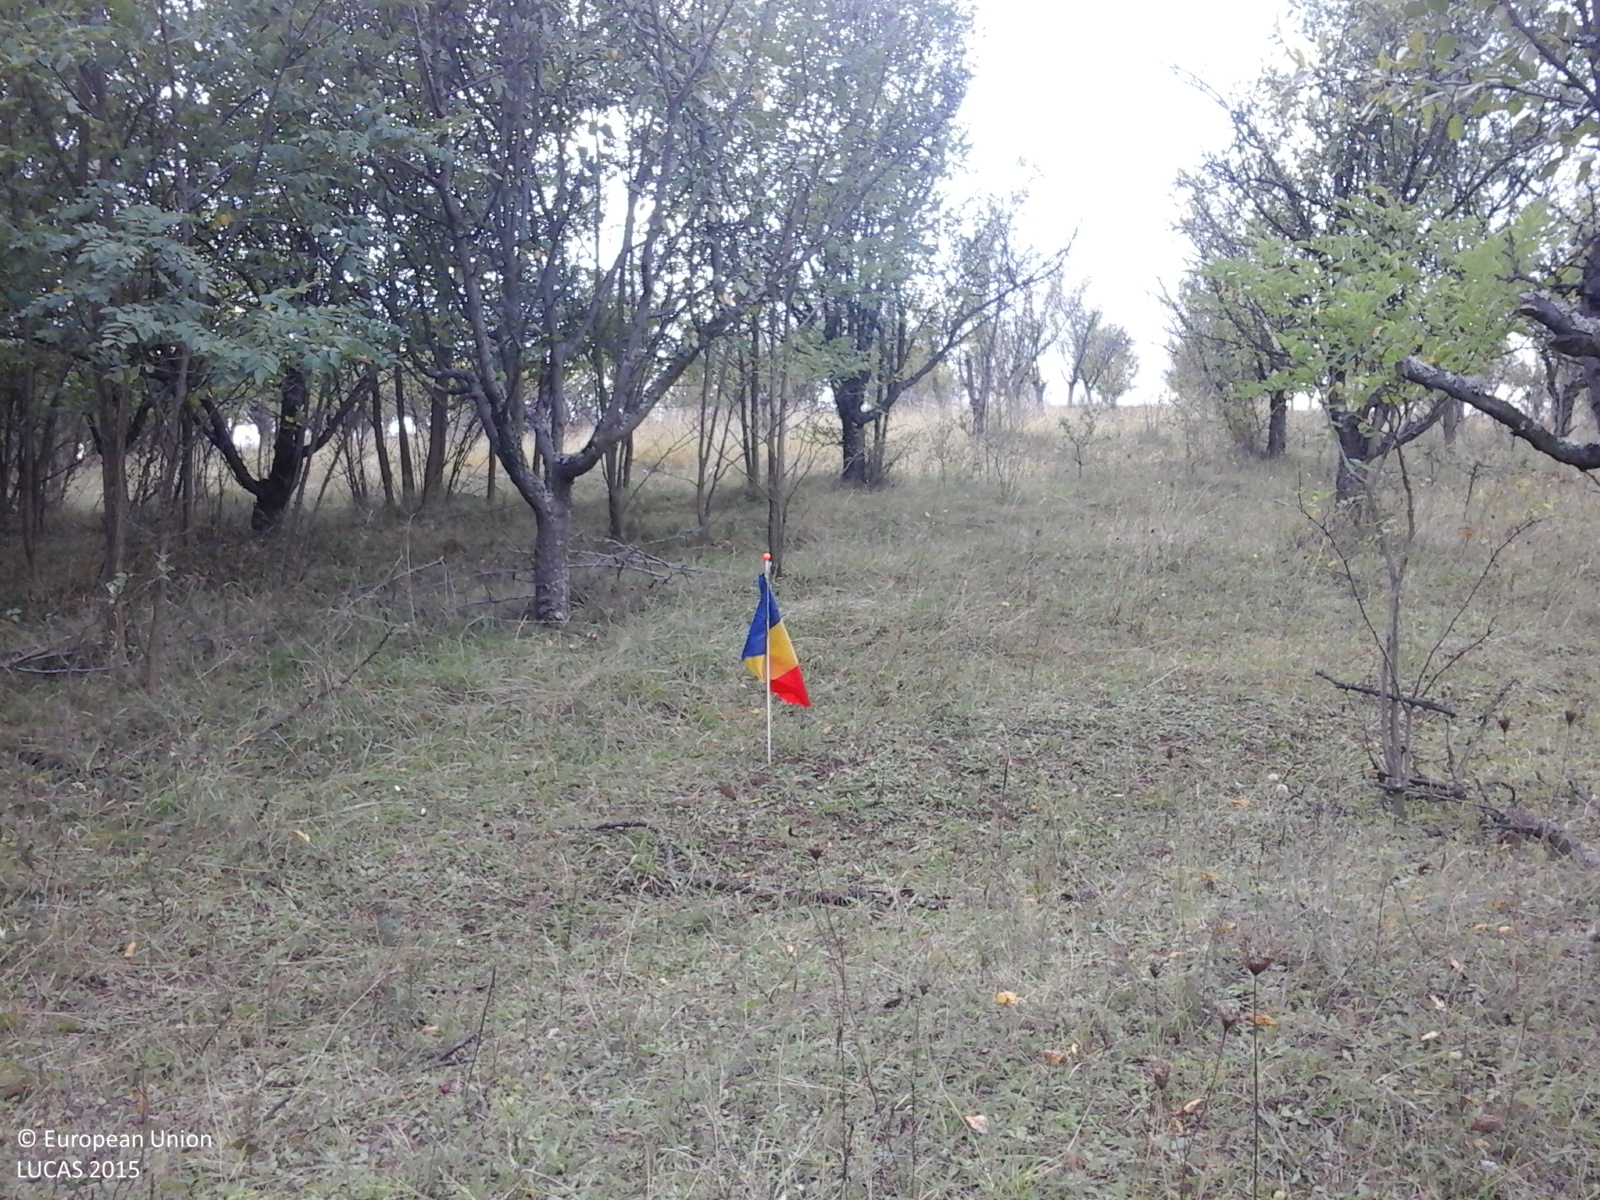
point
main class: Cropland
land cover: Other fruit trees and berries
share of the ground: 50 - 75 %
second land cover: Grassland without tree/shrub cover
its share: > 75 %
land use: Agriculture (excluding fallow land and kitchen gardens)
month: September
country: RO
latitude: 45.9779
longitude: 23.6848
